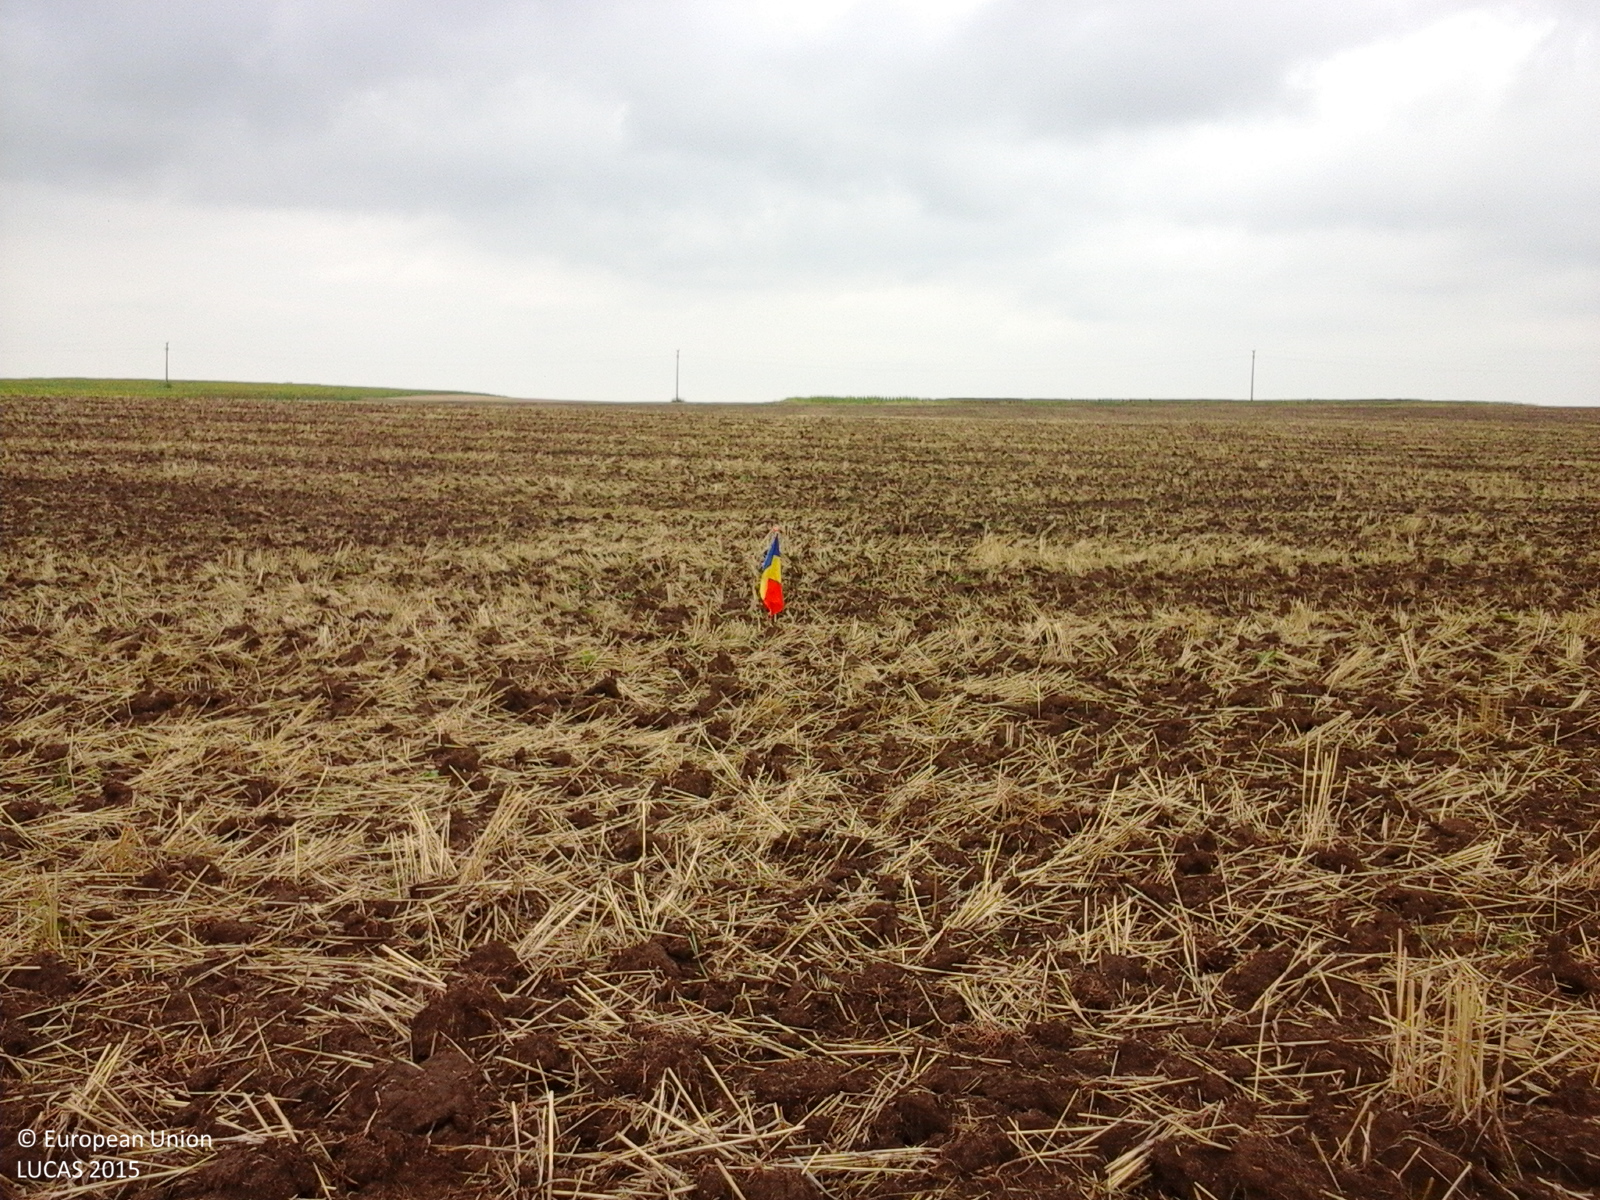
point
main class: Cropland
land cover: Common wheat
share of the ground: 25 - 50 %
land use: Agriculture (excluding fallow land and kitchen gardens)
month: August
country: RO
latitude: 45.9303
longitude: 21.3168
